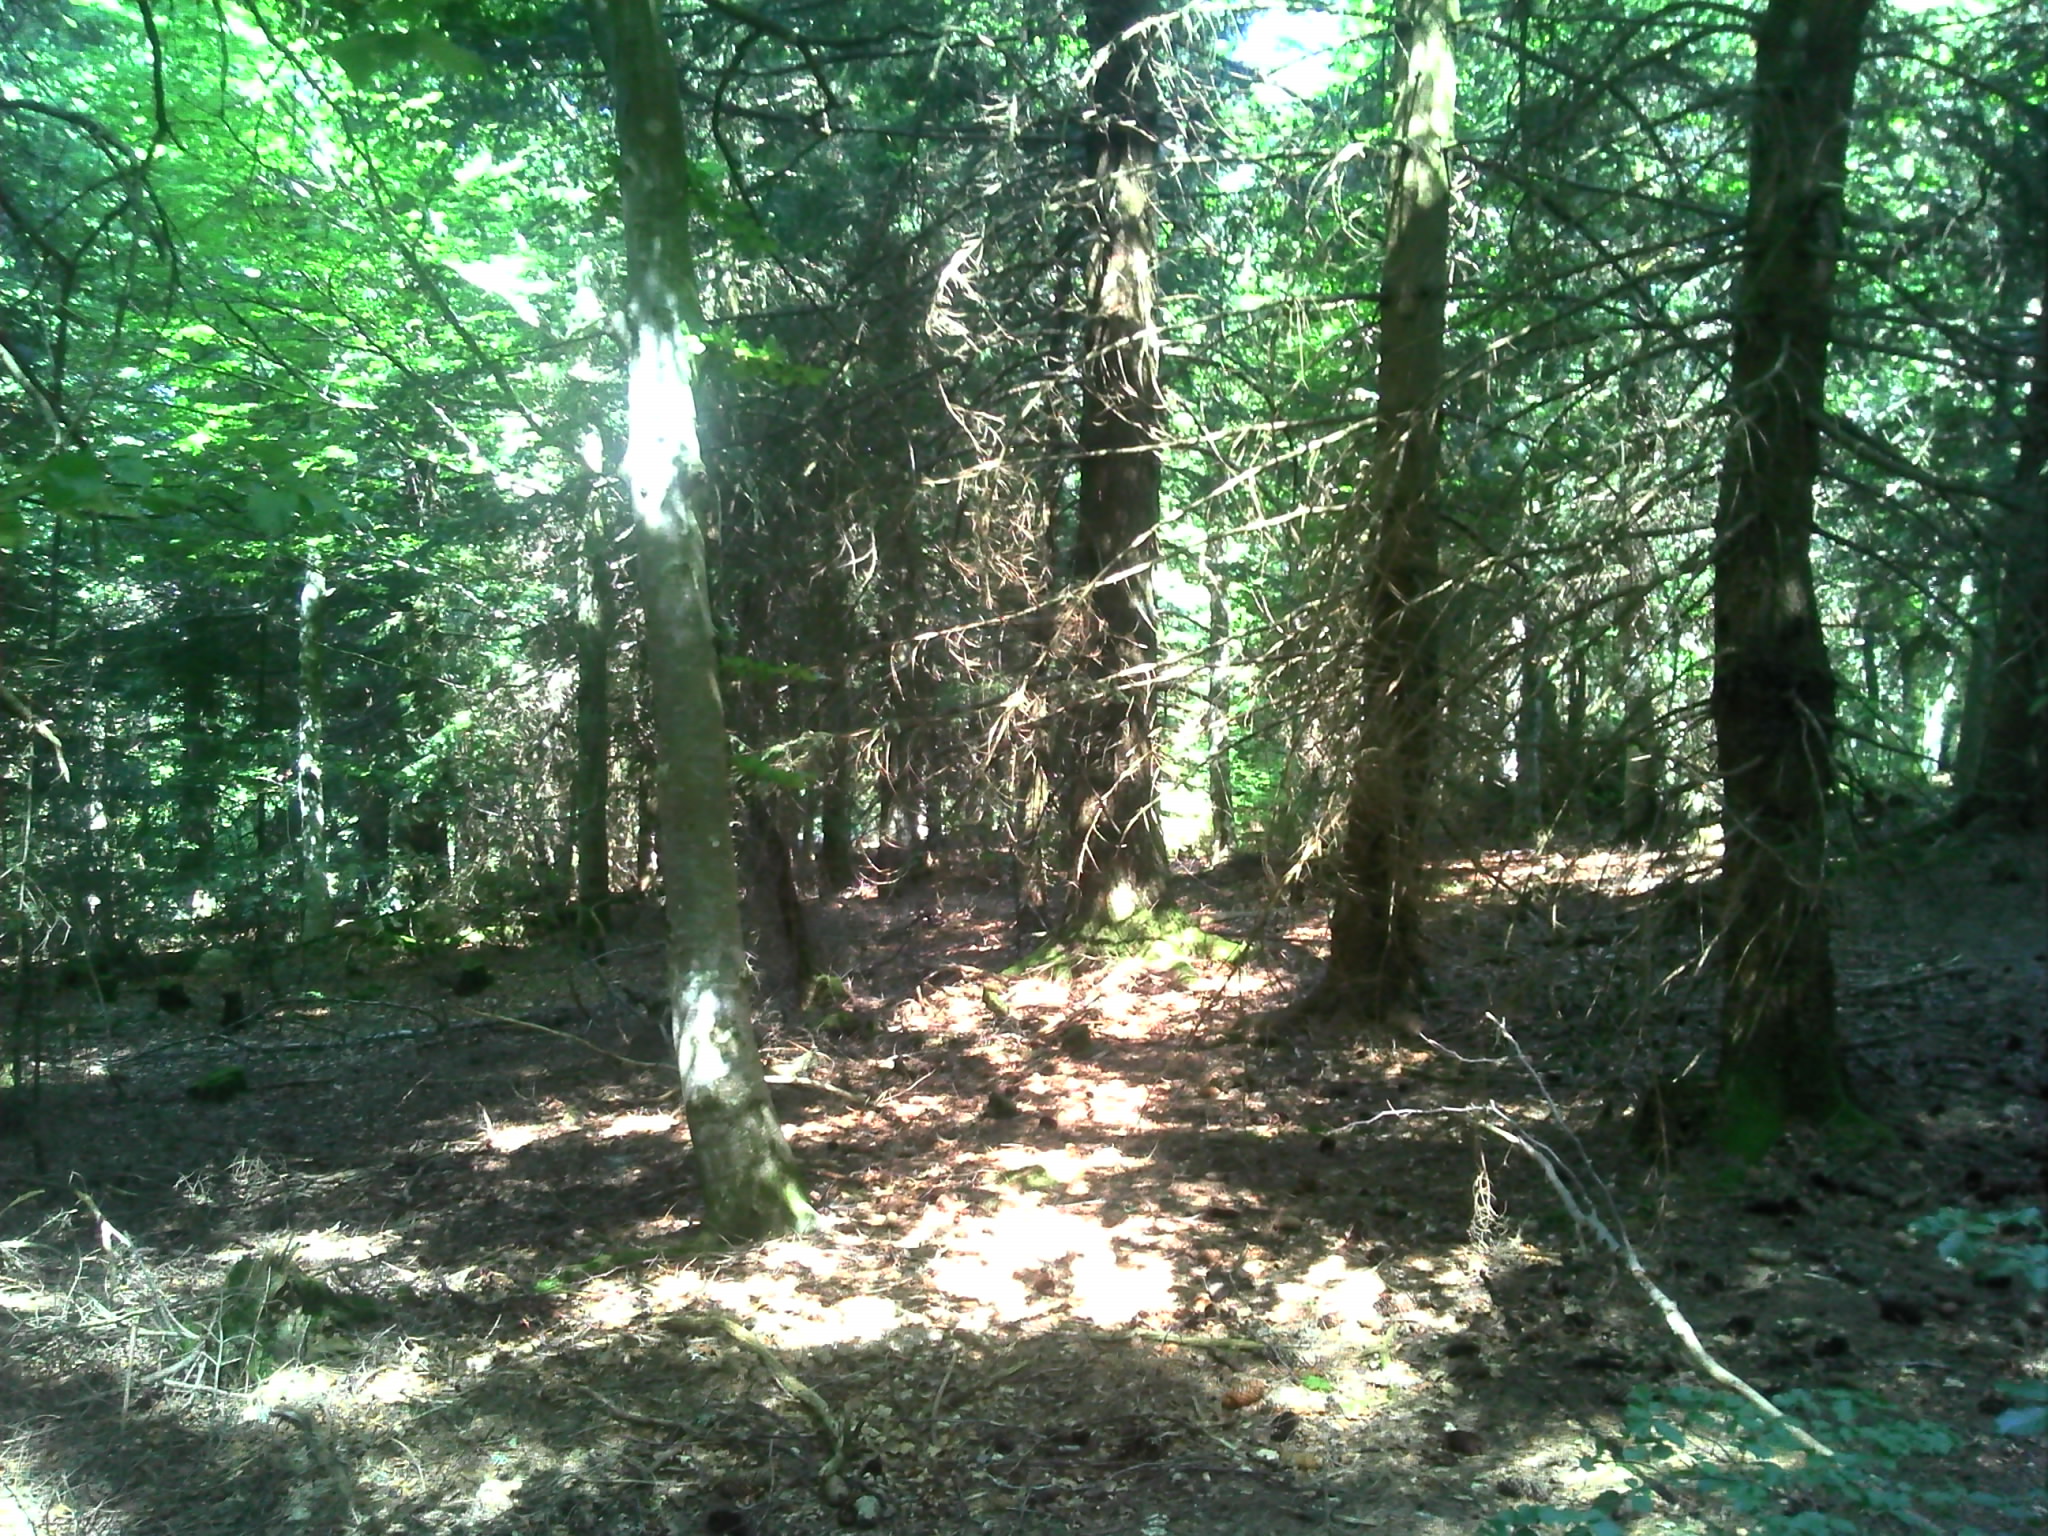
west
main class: Woodland
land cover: Spruce dominated mixed woodland
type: coniferous forest of the mediterranean region
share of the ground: > 75 %
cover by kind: coniferous forest trees 40 %, broadleaved forest trees 30 %, consolidated bare surface 15 %, herbaceous plants 10 %, lichens and mosses 5 %
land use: Forestry
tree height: > 5 m
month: July
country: FR
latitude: 44.0611
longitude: 3.5780
